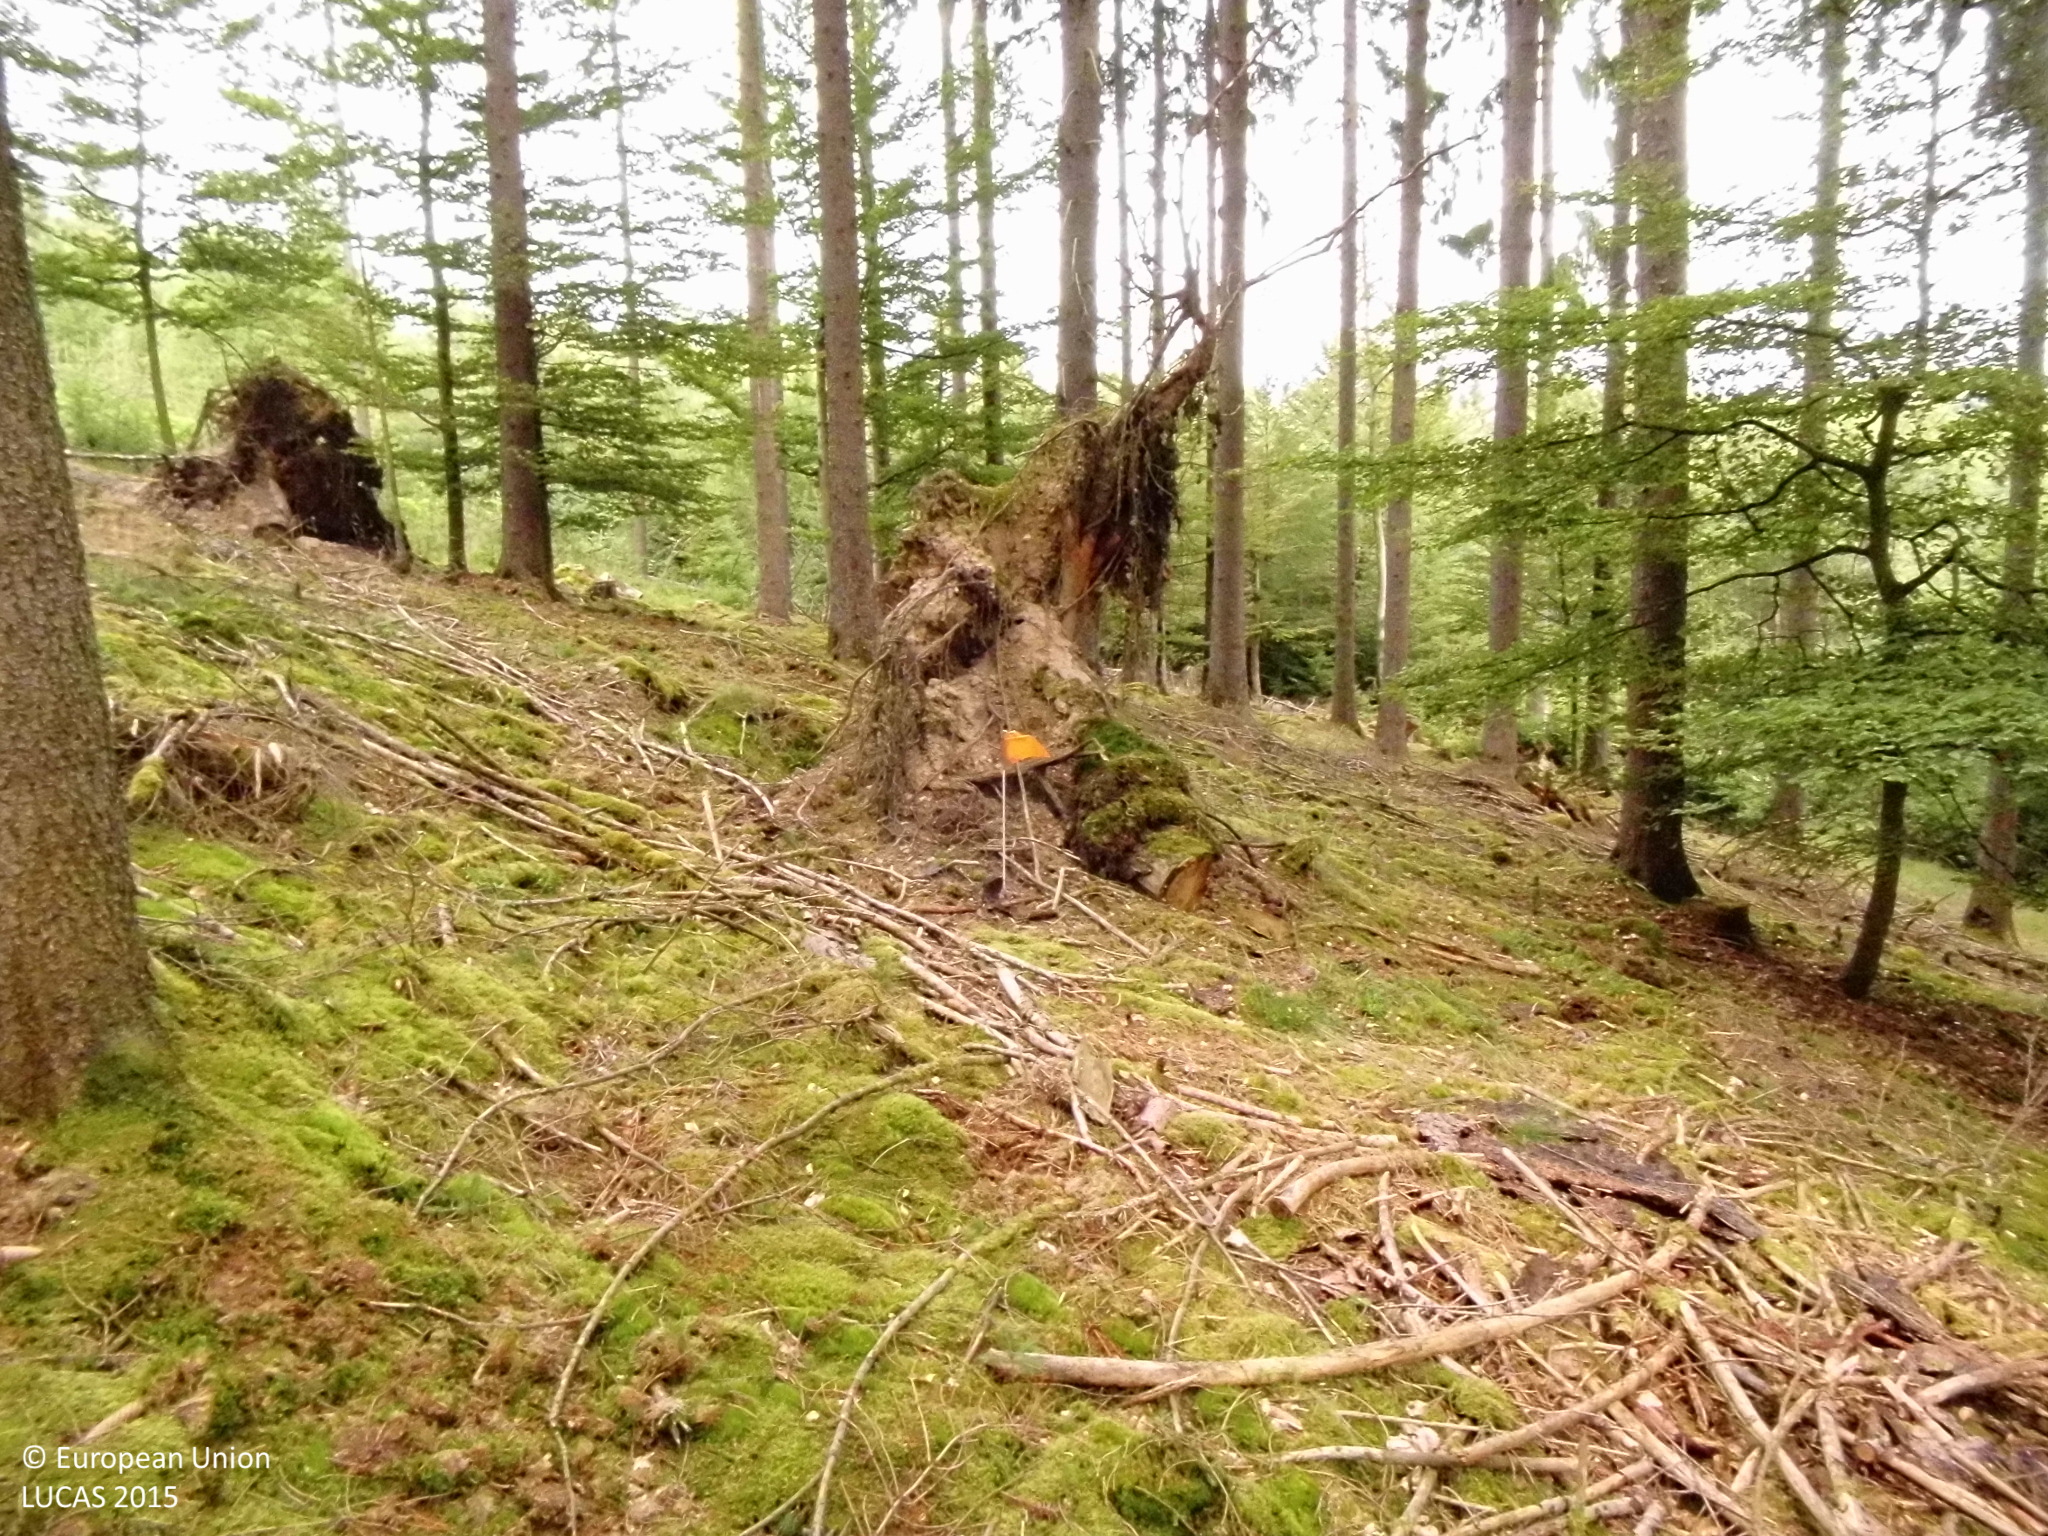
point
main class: Woodland
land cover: Spruce dominated coniferous woodland
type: hemiboreal forest and nemoral coniferous forest and mixed broadleaved-coniferous forest
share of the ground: > 75 %
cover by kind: coniferous forest trees 65 %, broadleaved forest trees 15 %, lichens and mosses 10 %, shrubs 5 %, unconsolidated bare surface 5 %
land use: Forestry
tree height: > 5 m
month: August
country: DE
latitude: 50.9847
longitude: 8.5901
